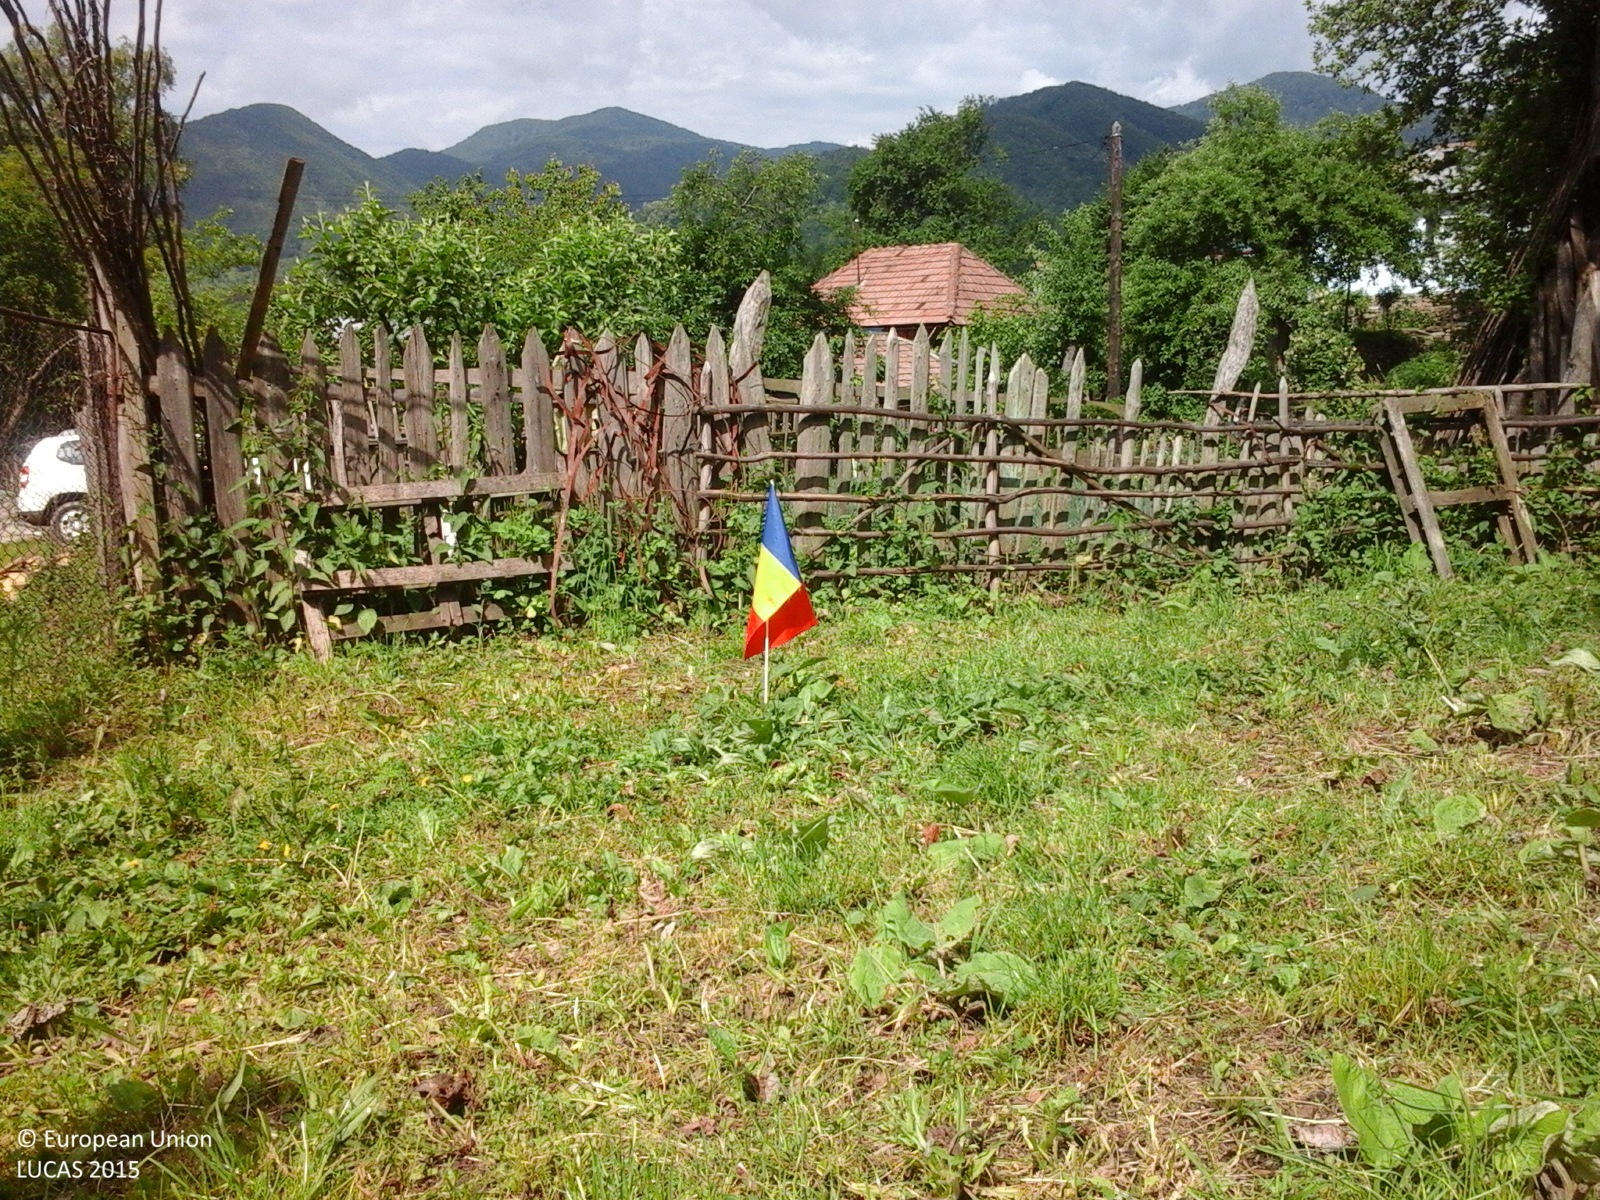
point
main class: Grassland
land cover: Grassland without tree/shrub cover
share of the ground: > 75 %
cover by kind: herbaceous plants 100 %
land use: Agriculture (excluding fallow land and kitchen gardens)
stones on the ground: < 10 %
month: May
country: RO
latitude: 45.4364
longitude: 26.3166
